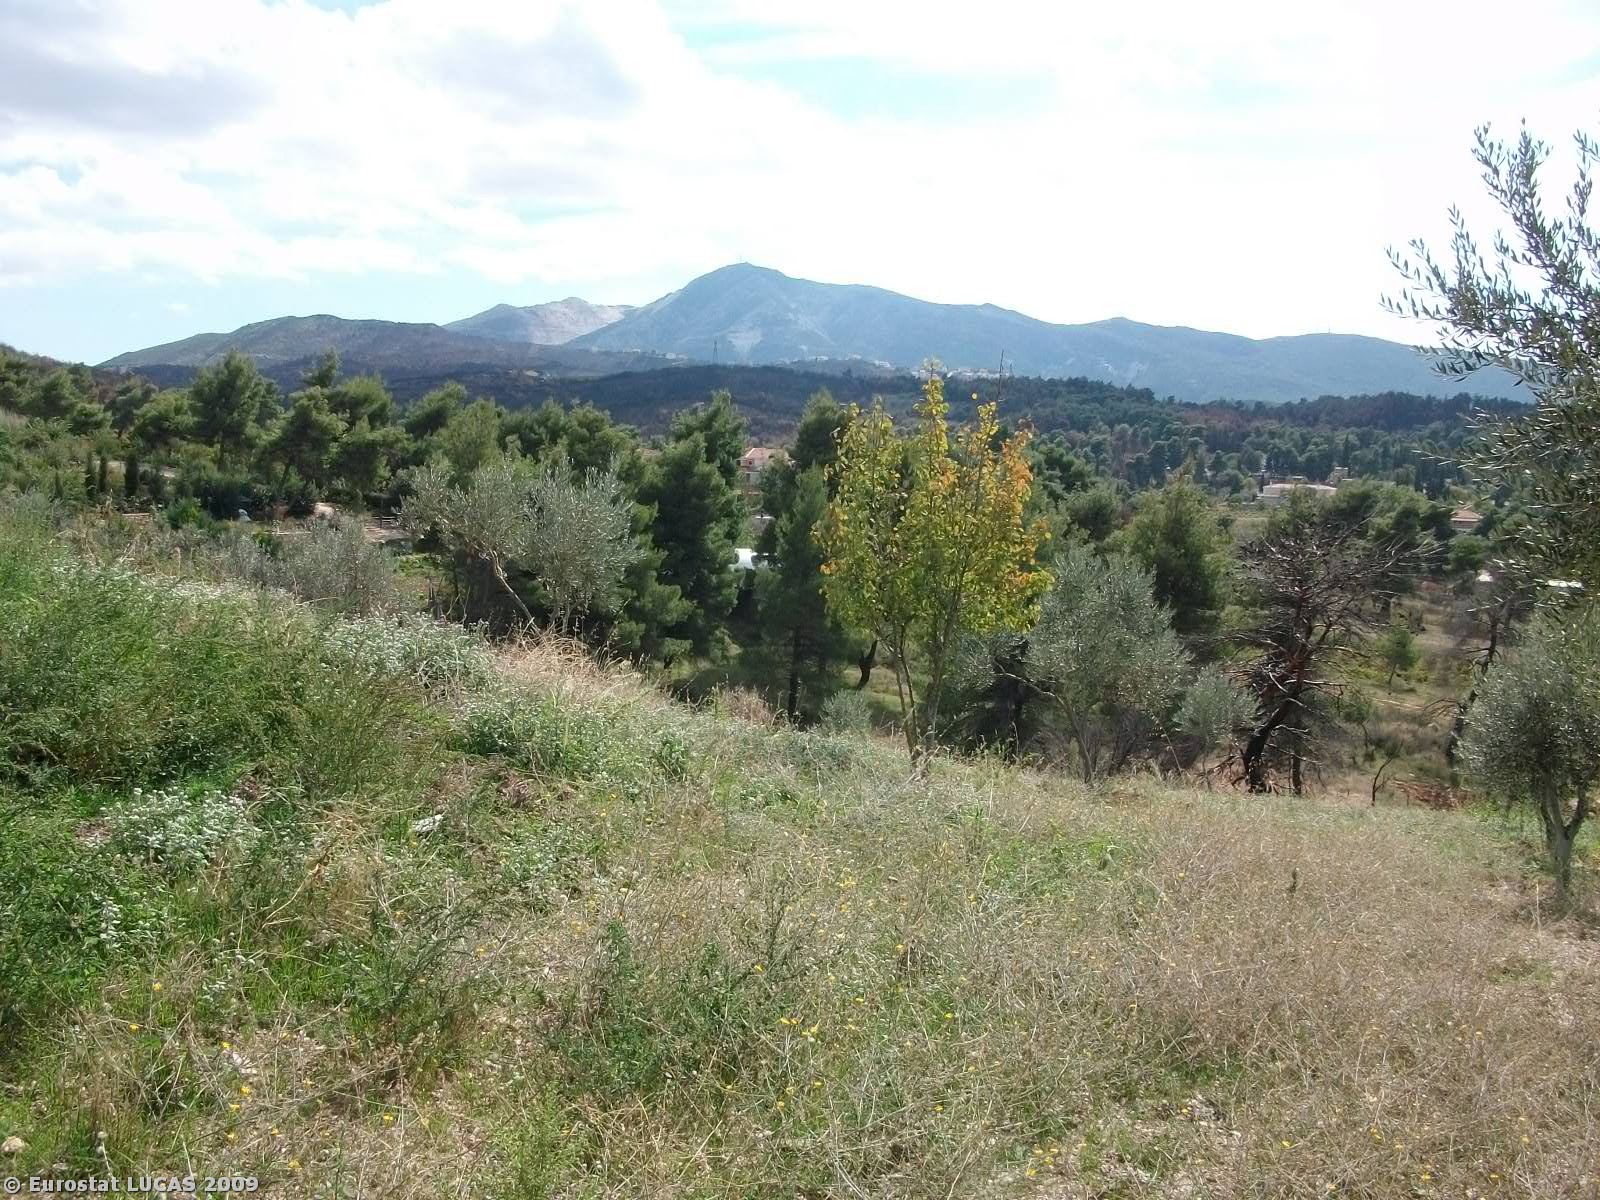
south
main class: Cropland
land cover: Olive groves
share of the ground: 25 - 50 %
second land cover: Grassland with sparse tree/shrub cover
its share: > 75 %
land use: Agriculture (excluding fallow land and kitchen gardens)
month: September
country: GR
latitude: 38.1364
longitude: 23.8924
